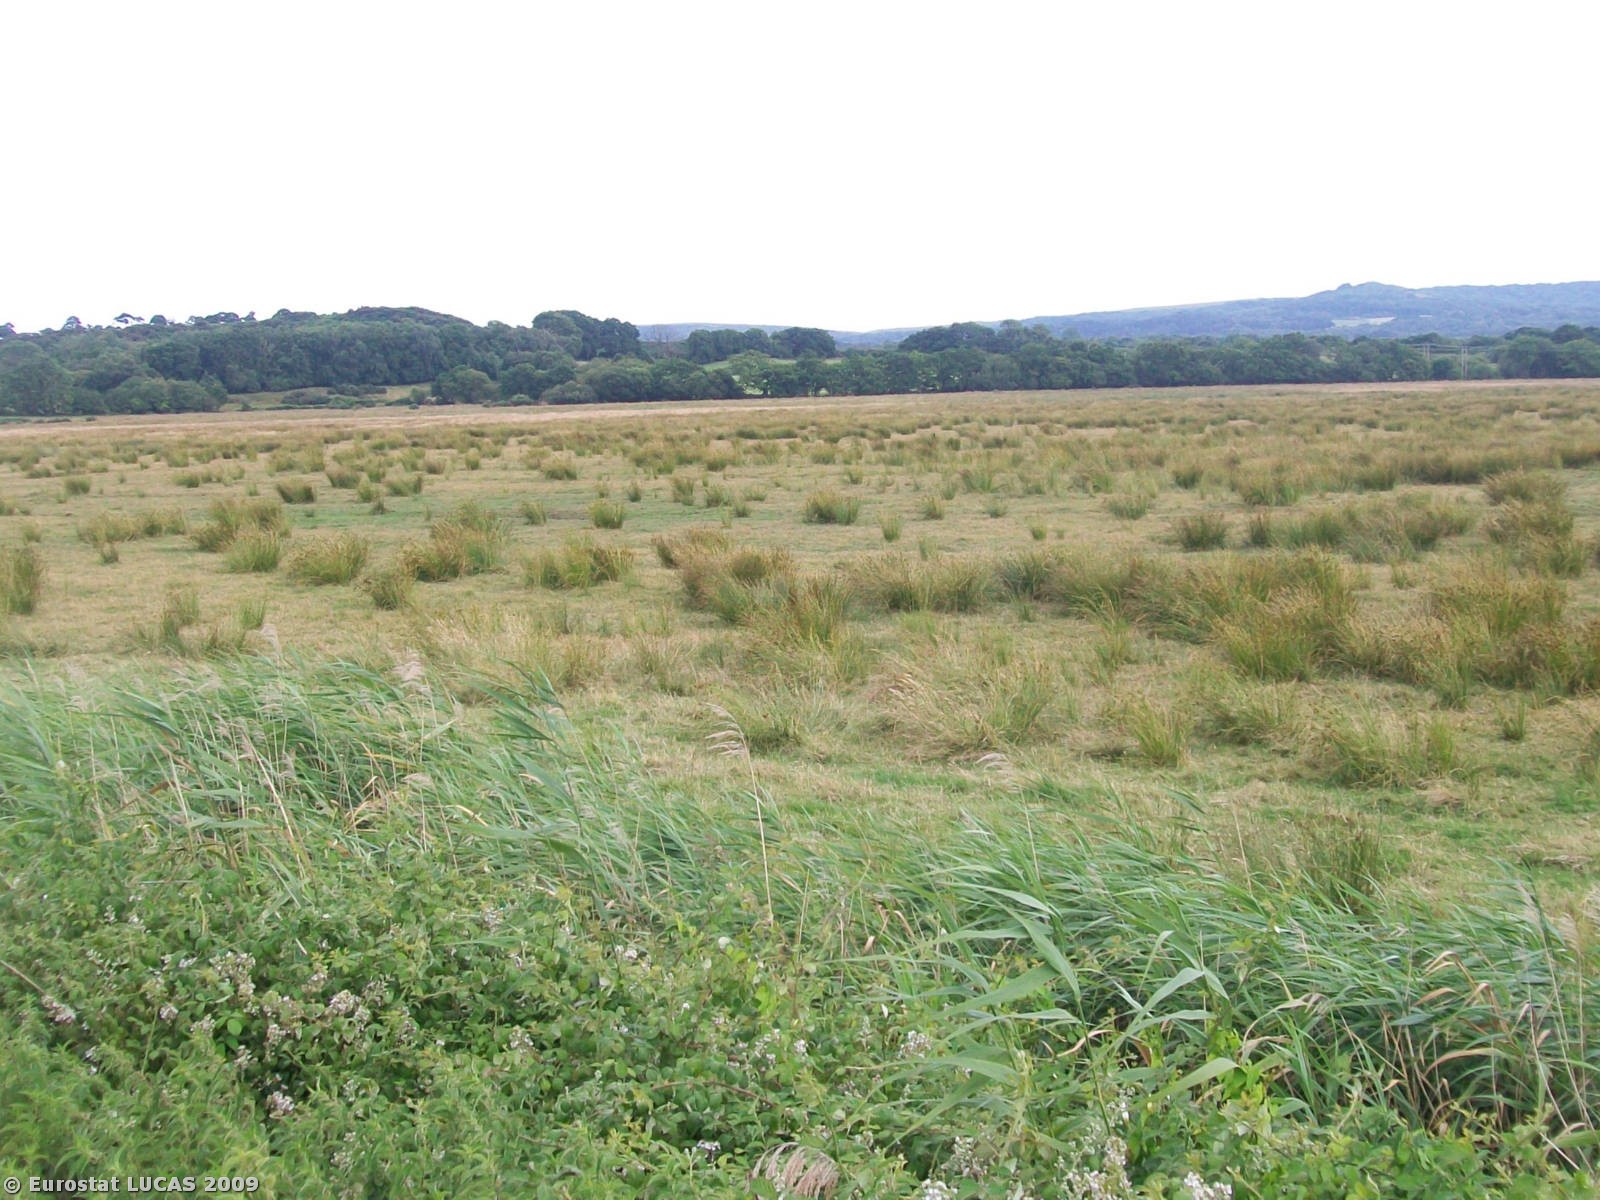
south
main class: Grassland
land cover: Grassland without tree/shrub cover
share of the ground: > 75 %
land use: Agriculture (excluding fallow land and kitchen gardens)
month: July
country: GB
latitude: 50.6823
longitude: -2.1039
